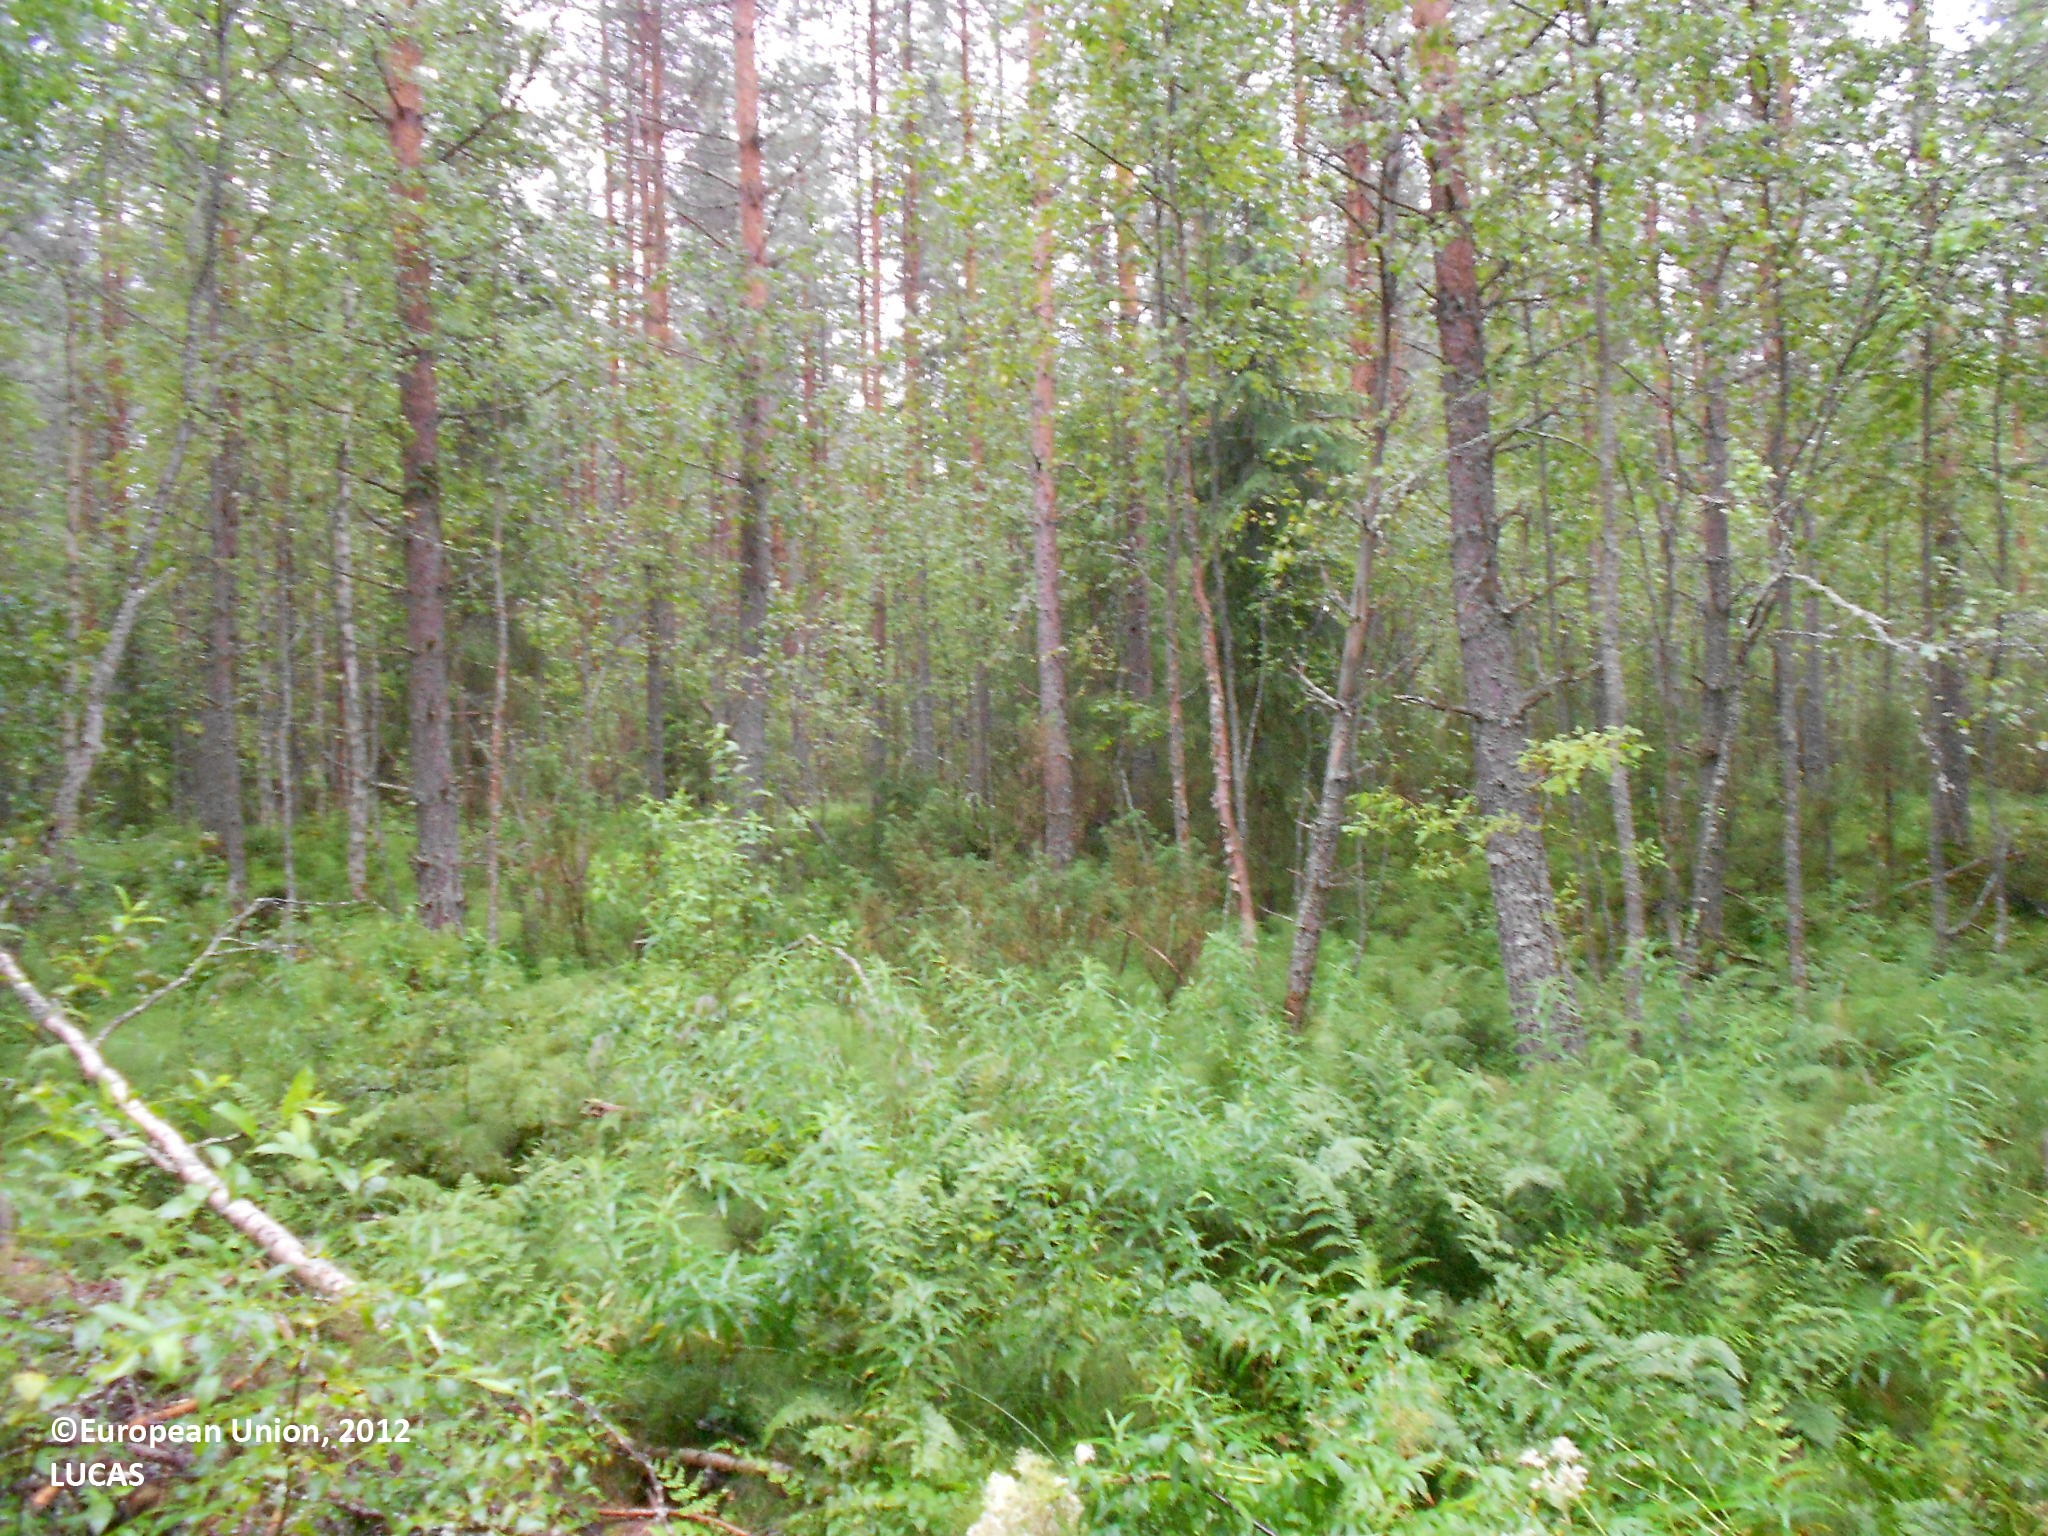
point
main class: Woodland
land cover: Pine dominated mixed woodland
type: boreal forest
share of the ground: 50 - 75 %
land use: Forestry
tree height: > 5 m
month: August
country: FI
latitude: 63.8214
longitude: 28.6162
